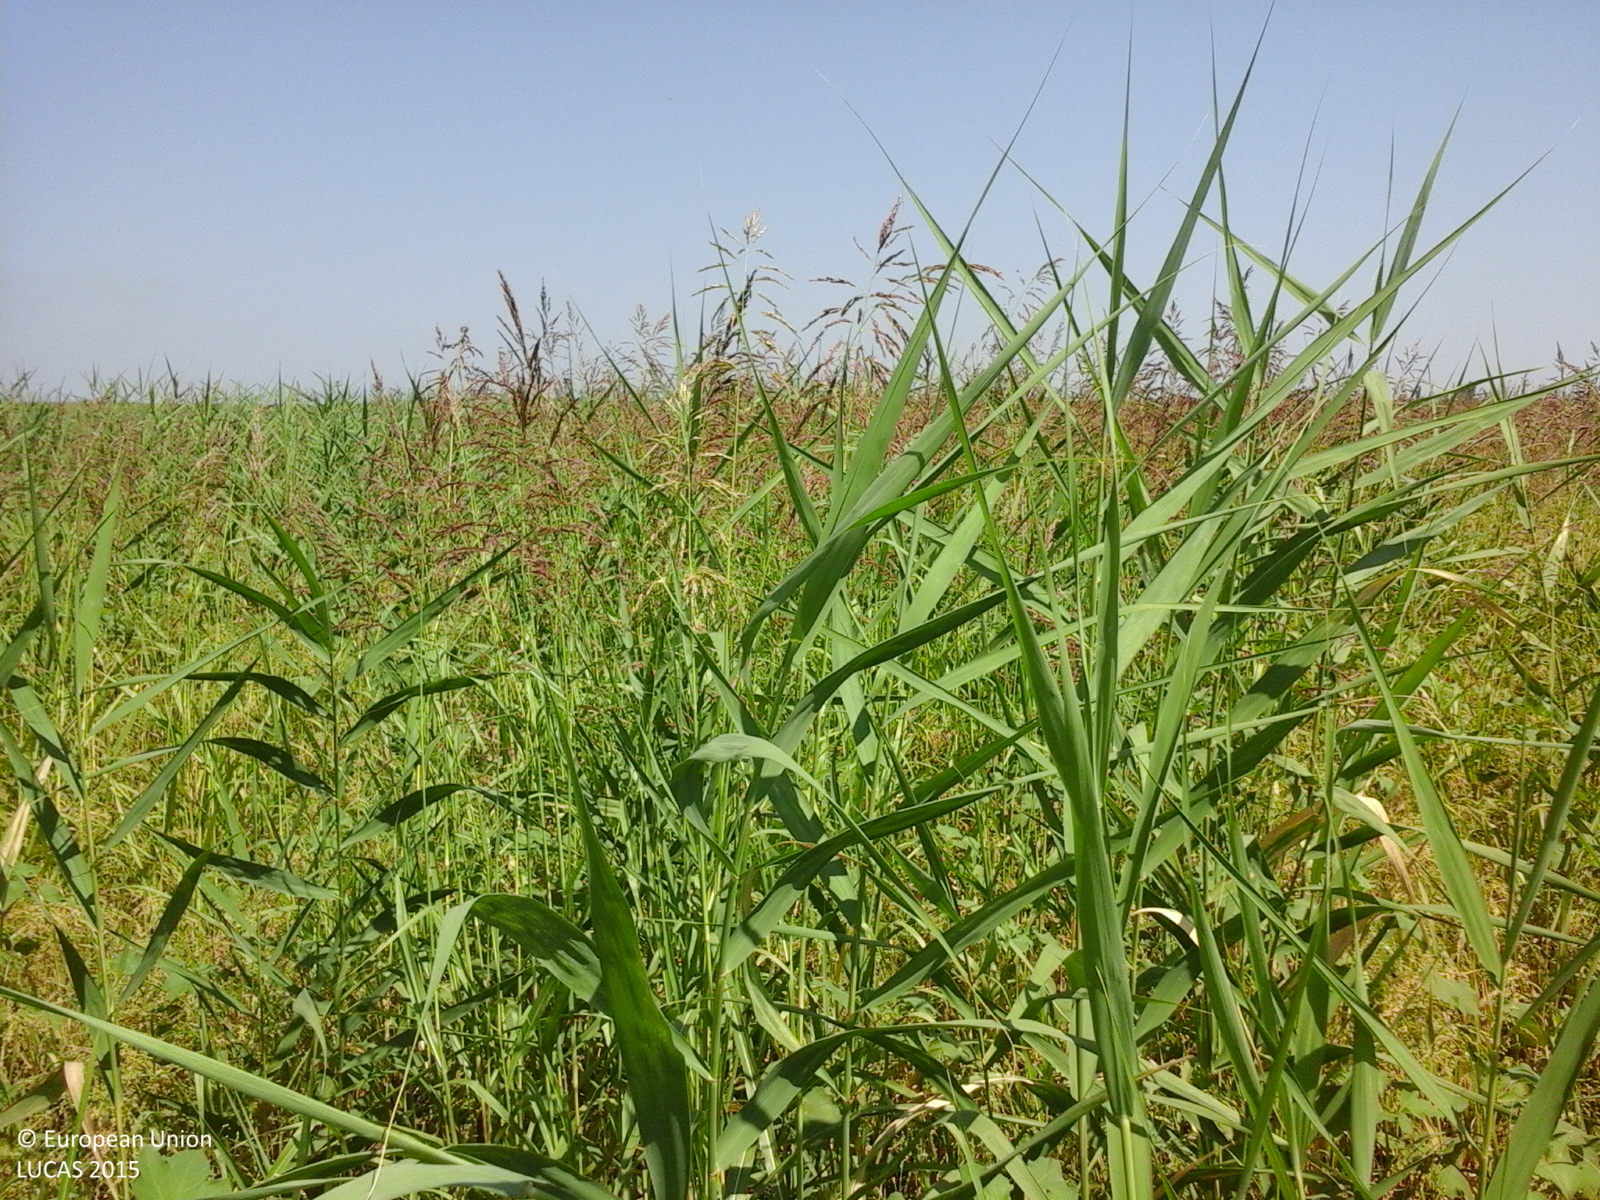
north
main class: Grassland
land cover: Spontaneously vegetated surfaces
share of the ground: > 75 %
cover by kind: herbaceous plants 100 %
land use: Fallow land
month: July
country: RO
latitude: 45.0383
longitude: 27.1883
